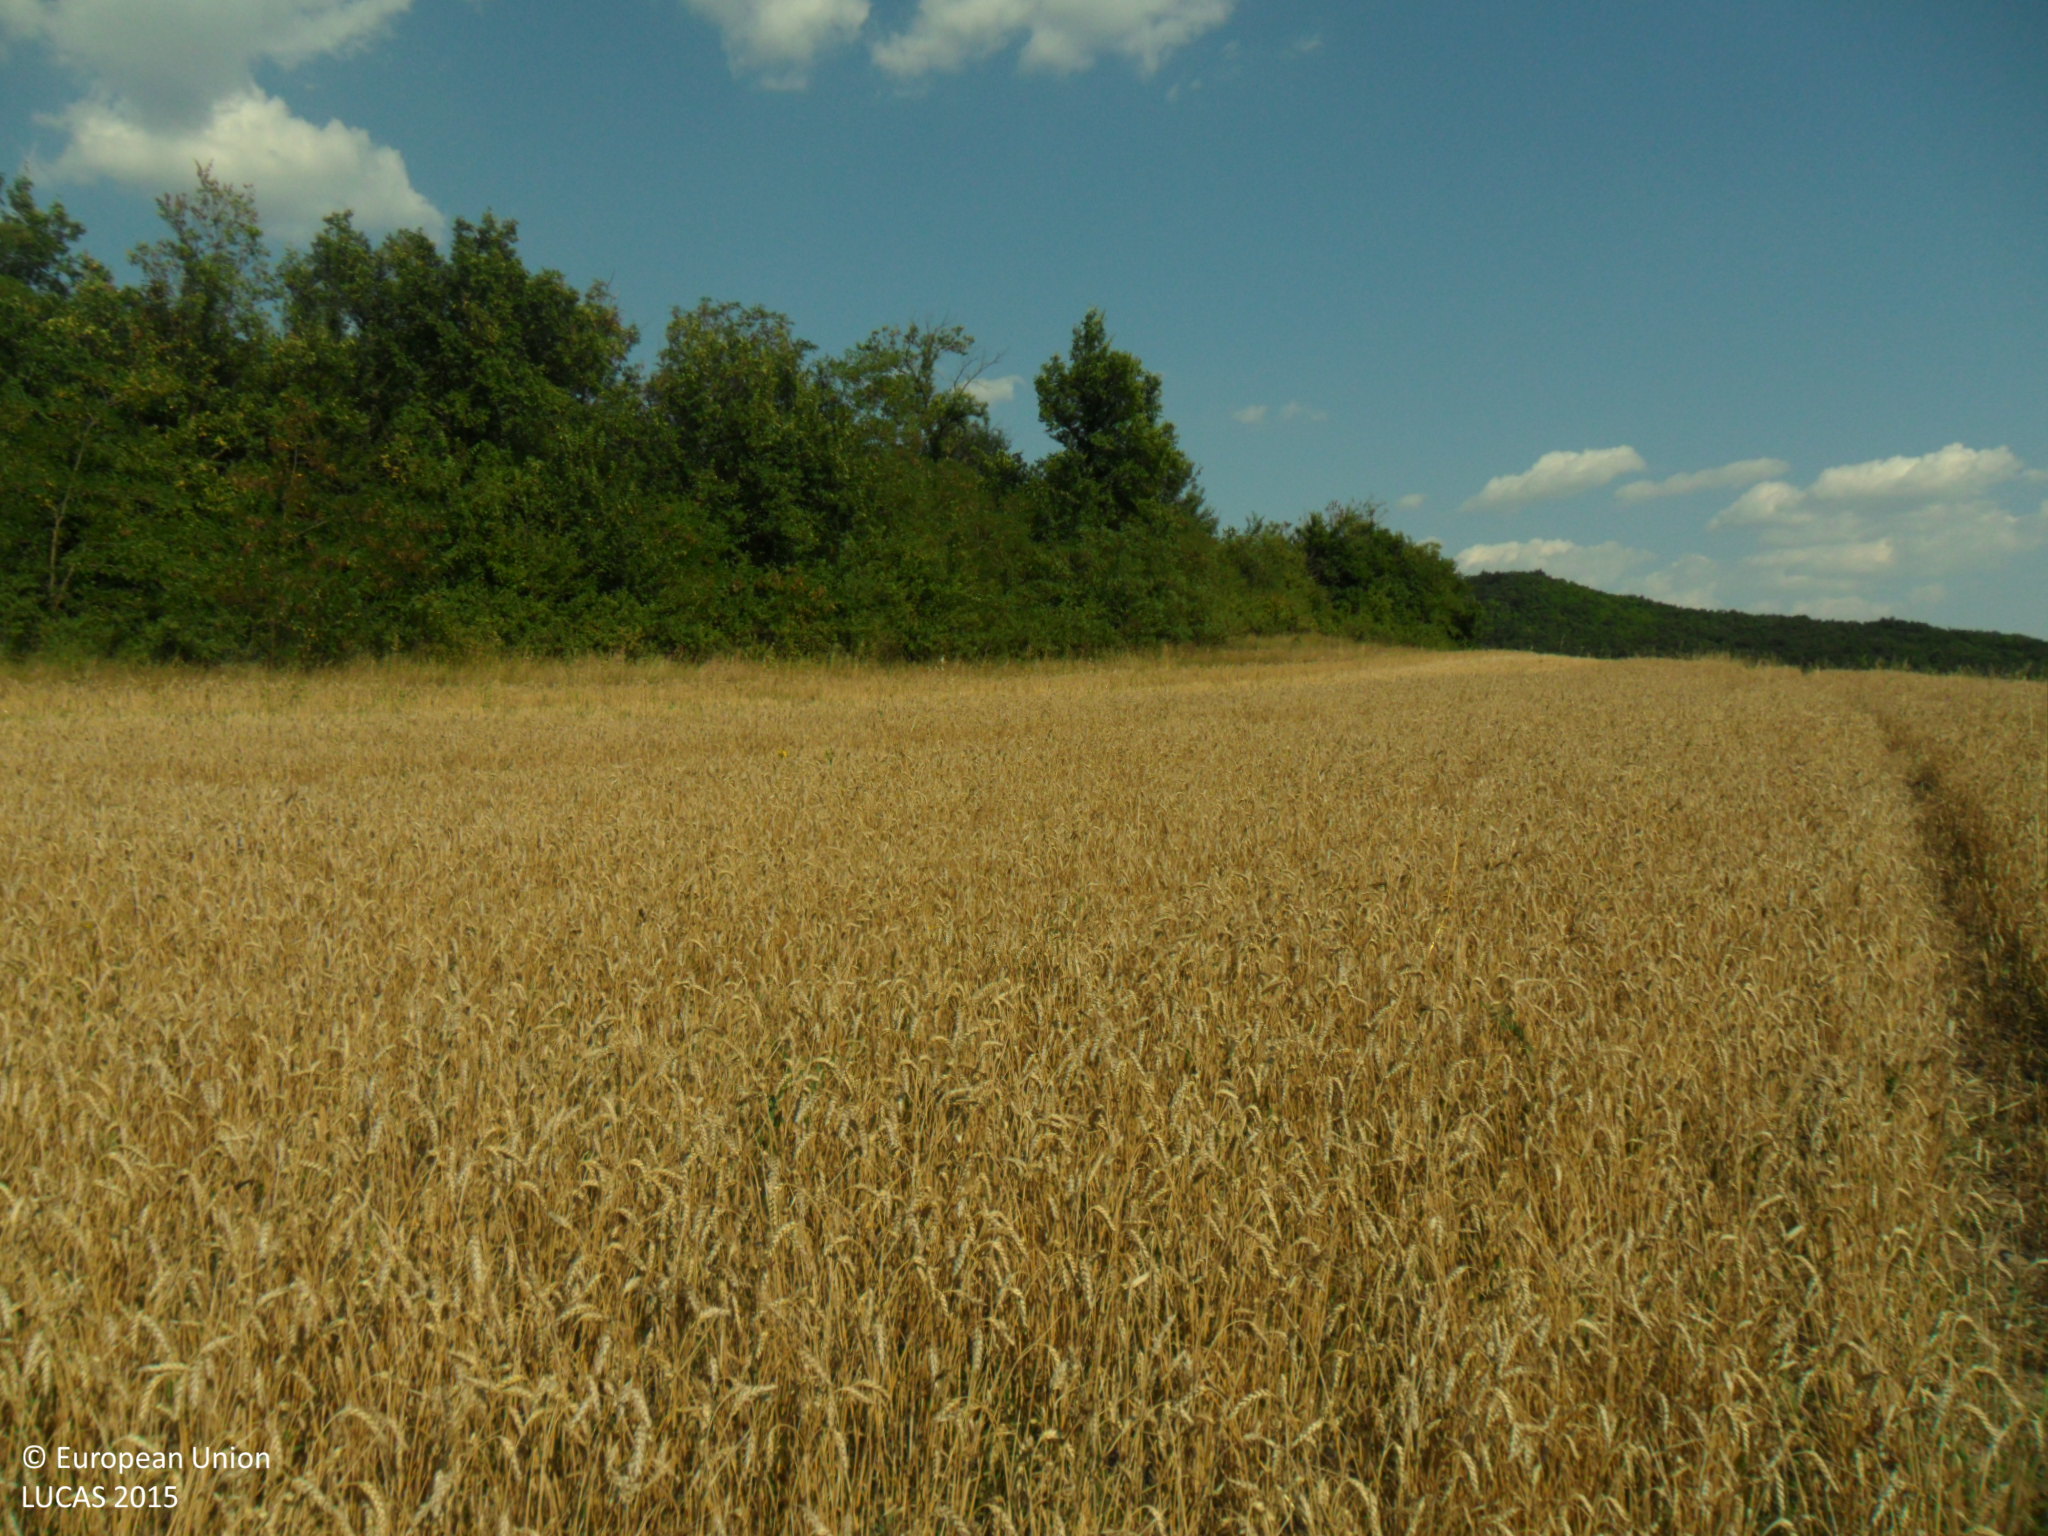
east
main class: Cropland
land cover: Common wheat
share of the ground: > 75 %
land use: Agriculture (excluding fallow land and kitchen gardens)
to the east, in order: Common wheat; Grass margins; Tracks; Grass margins; Shrubland with sparse tree cover; Other mixed woodland; Shrubland with sparse tree cover; Grass margins; Tracks; Grass margins; Common wheat
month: July
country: BG
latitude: 43.3945
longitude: 26.5621
